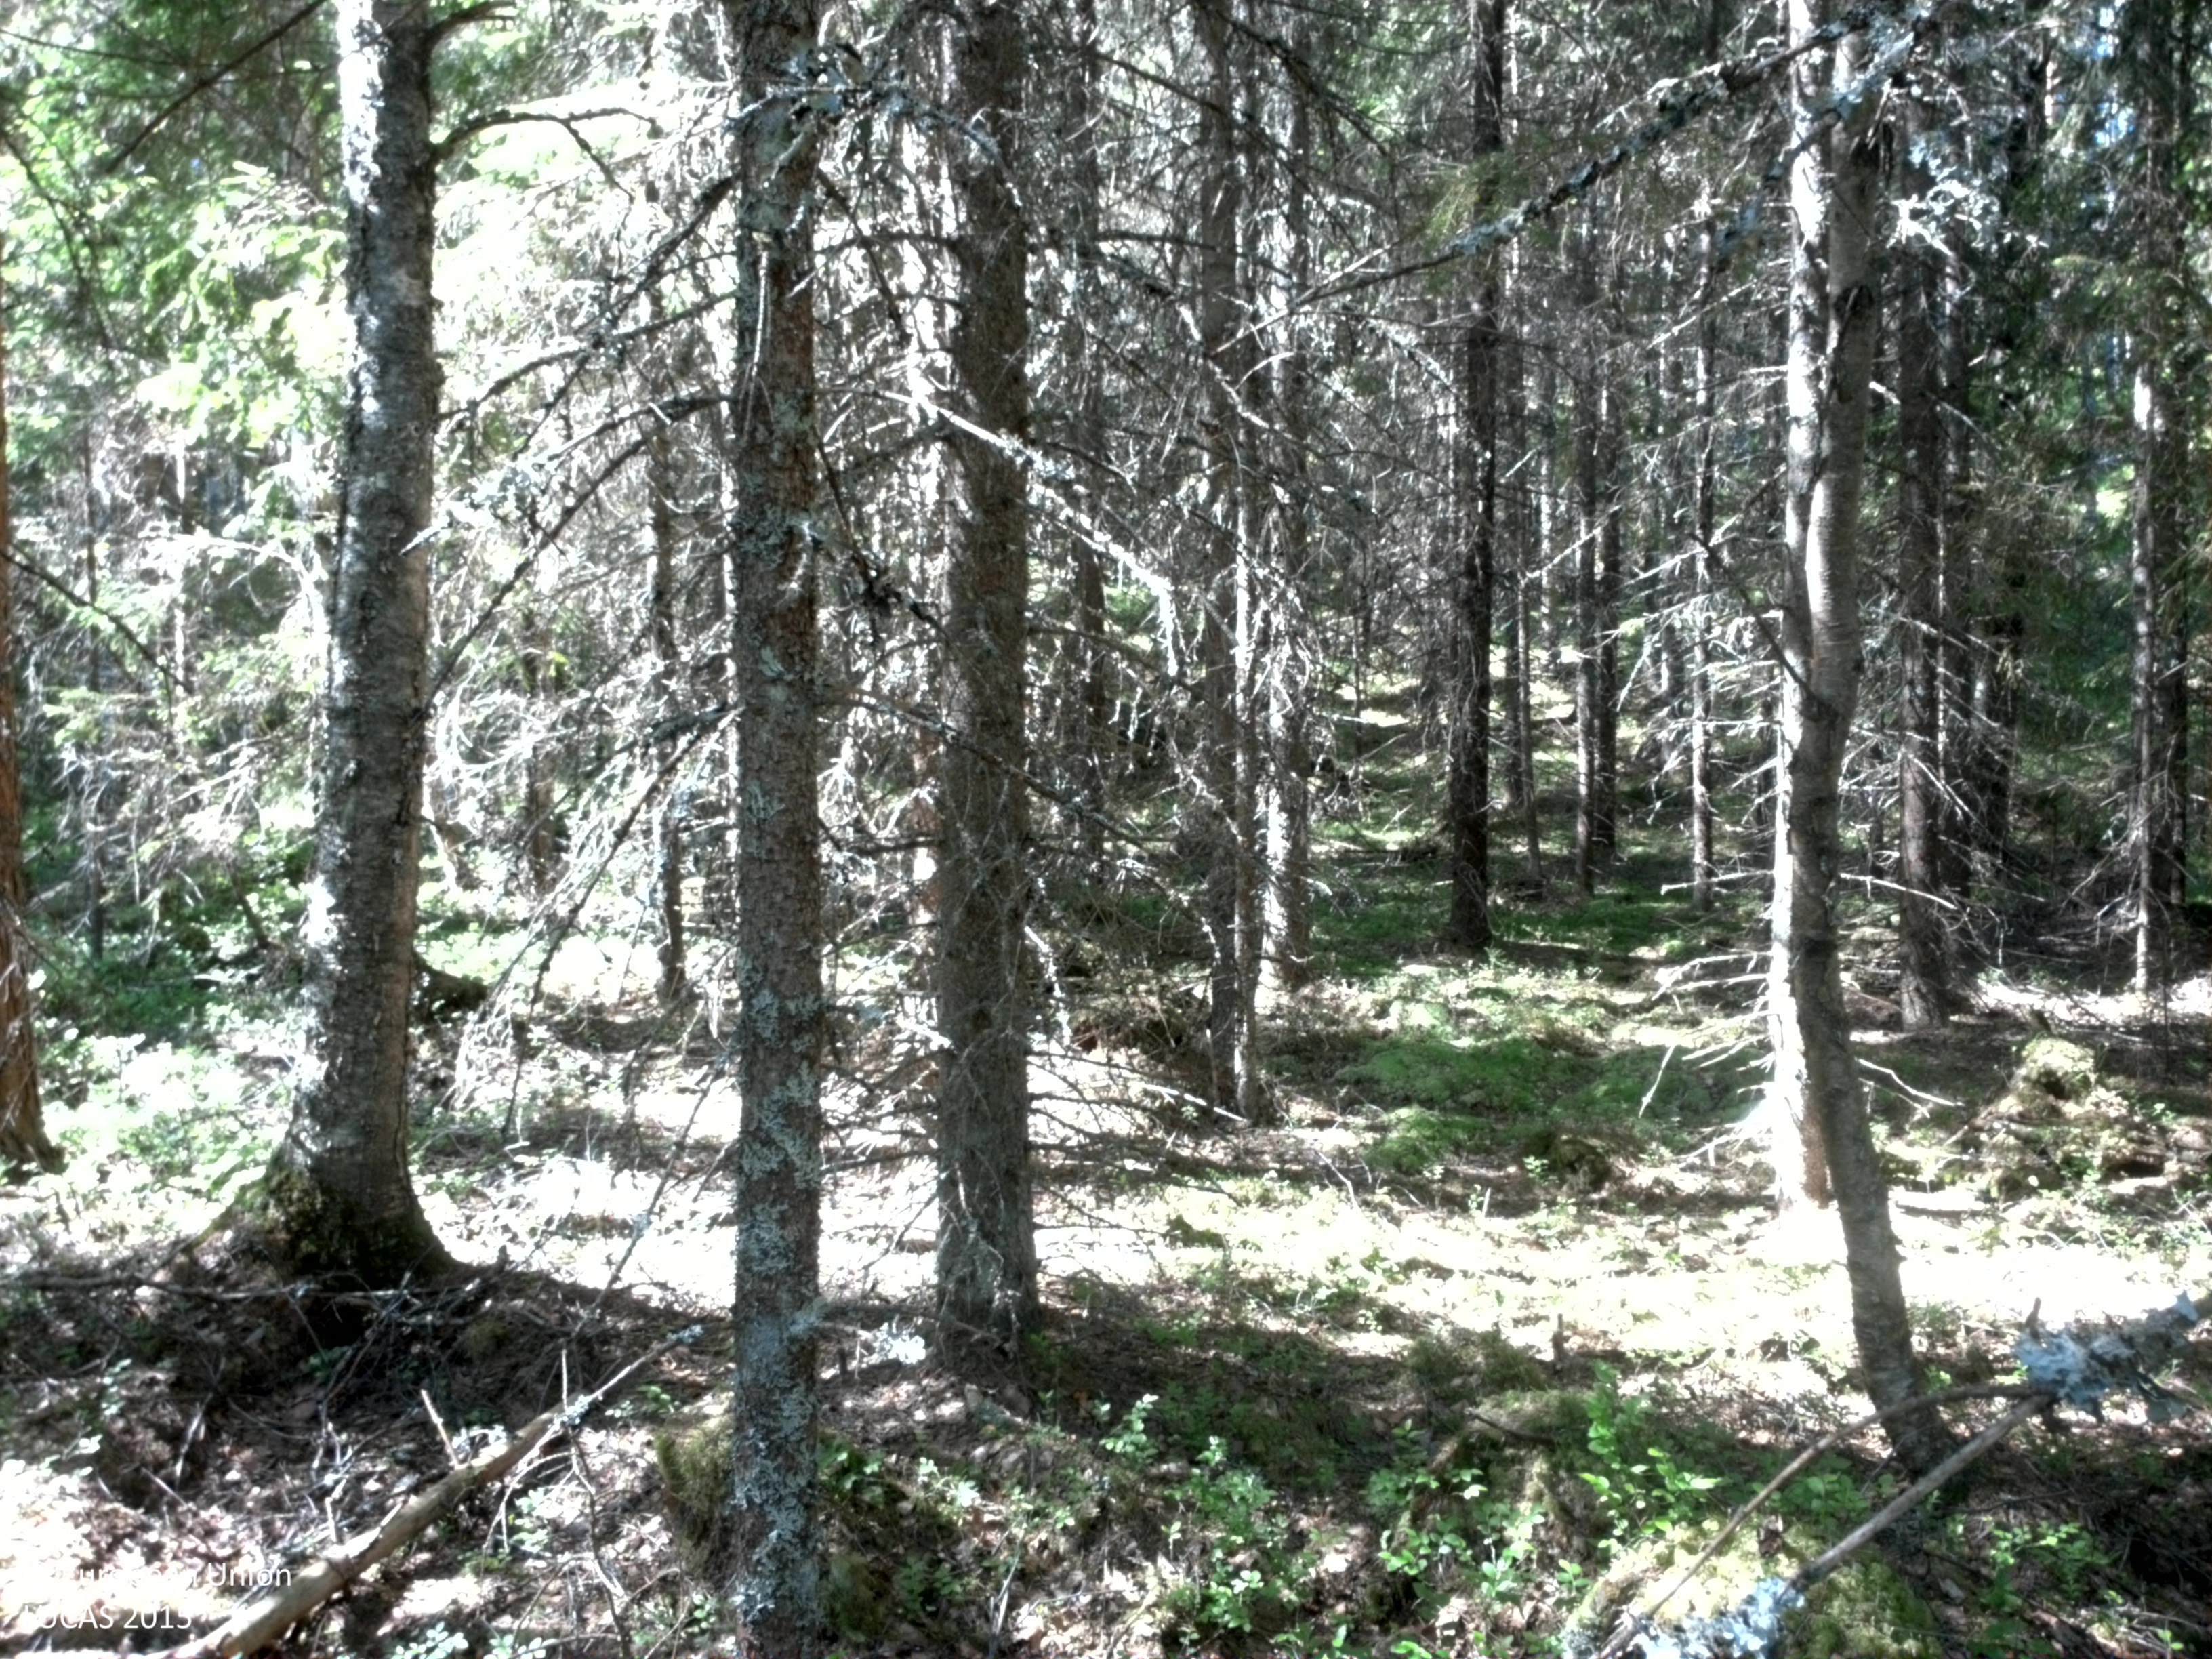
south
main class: Woodland
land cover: Spruce dominated mixed woodland
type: boreal forest
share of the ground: 50 - 75 %
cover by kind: coniferous forest trees 45 %, shrubs 25 %, broadleaved forest trees 15 %, lichens and mosses 15 %
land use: Forestry
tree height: > 5 m
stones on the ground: < 10 %
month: July
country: SE
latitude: 59.7712
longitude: 11.9356
